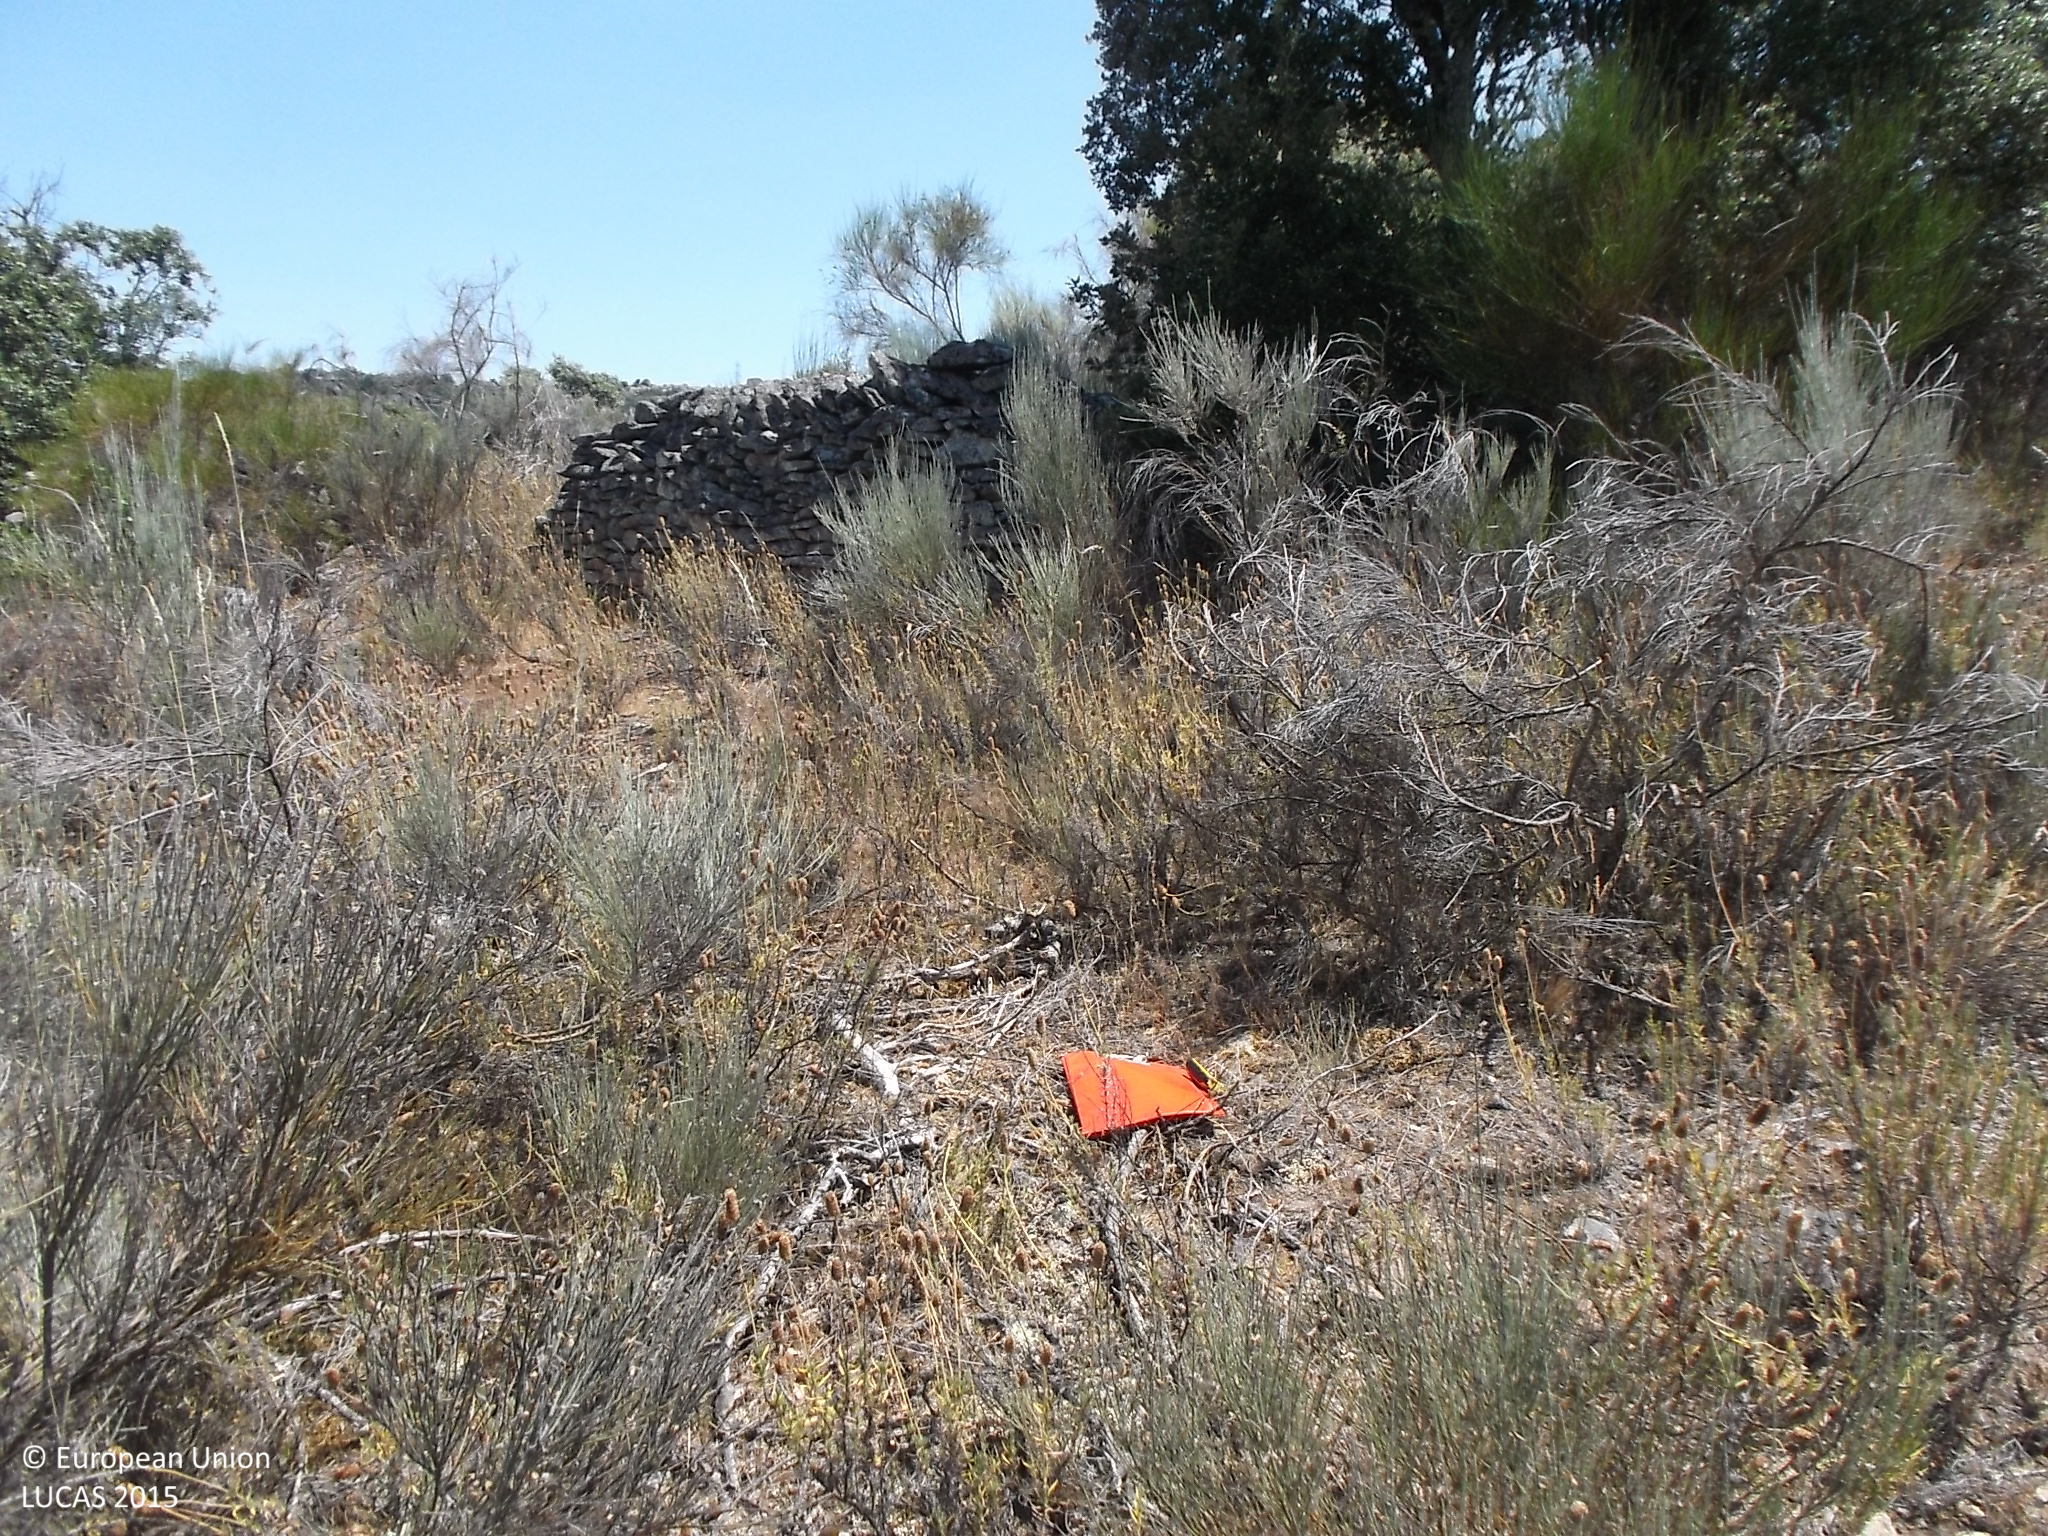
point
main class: Shrubland
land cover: Shrubland with sparse tree cover
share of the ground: > 75 %
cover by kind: shrubs 80 %, herbaceous plants 15 %, broadleaved forest trees 5 %
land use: Semi-natural and natural areas not in use
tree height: < 5 m
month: July
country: ES
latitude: 41.2712
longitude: -6.3917
